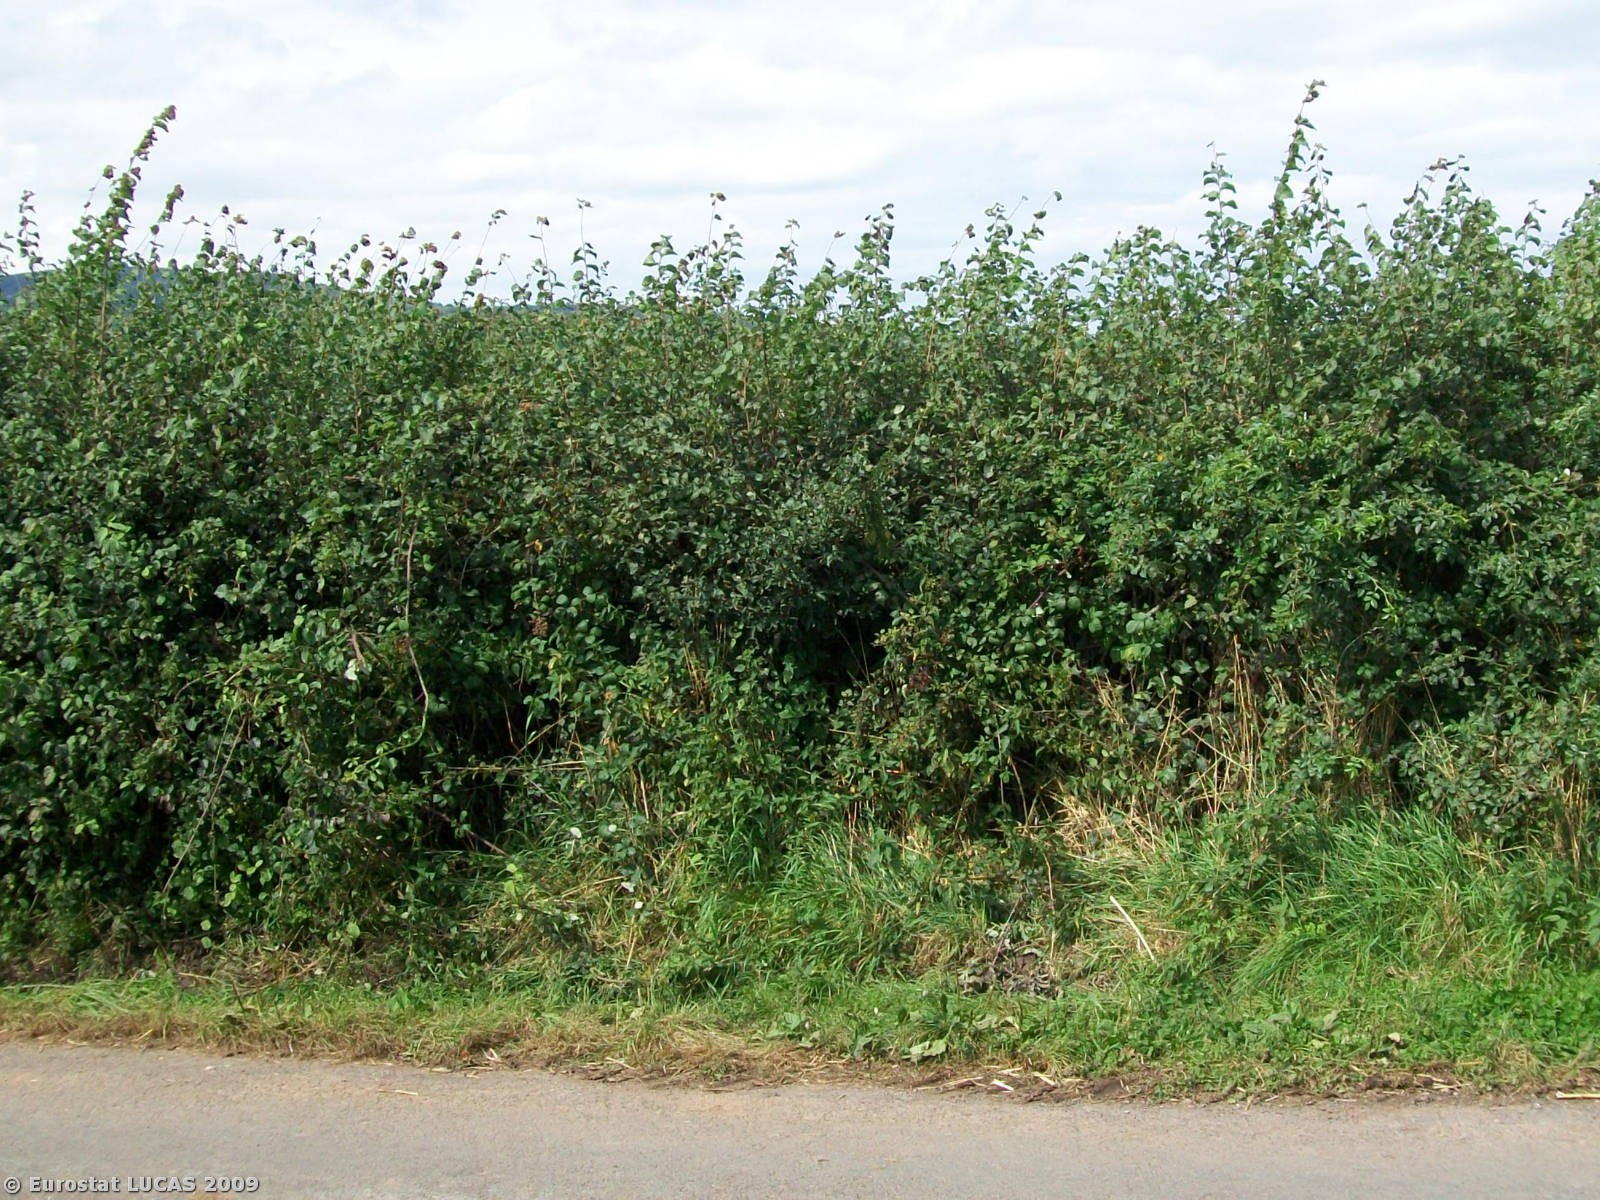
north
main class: Grassland
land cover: Grassland without tree/shrub cover
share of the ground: > 75 %
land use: Agriculture (excluding fallow land and kitchen gardens)
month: August
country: GB
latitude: 51.8526
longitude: -2.3905
